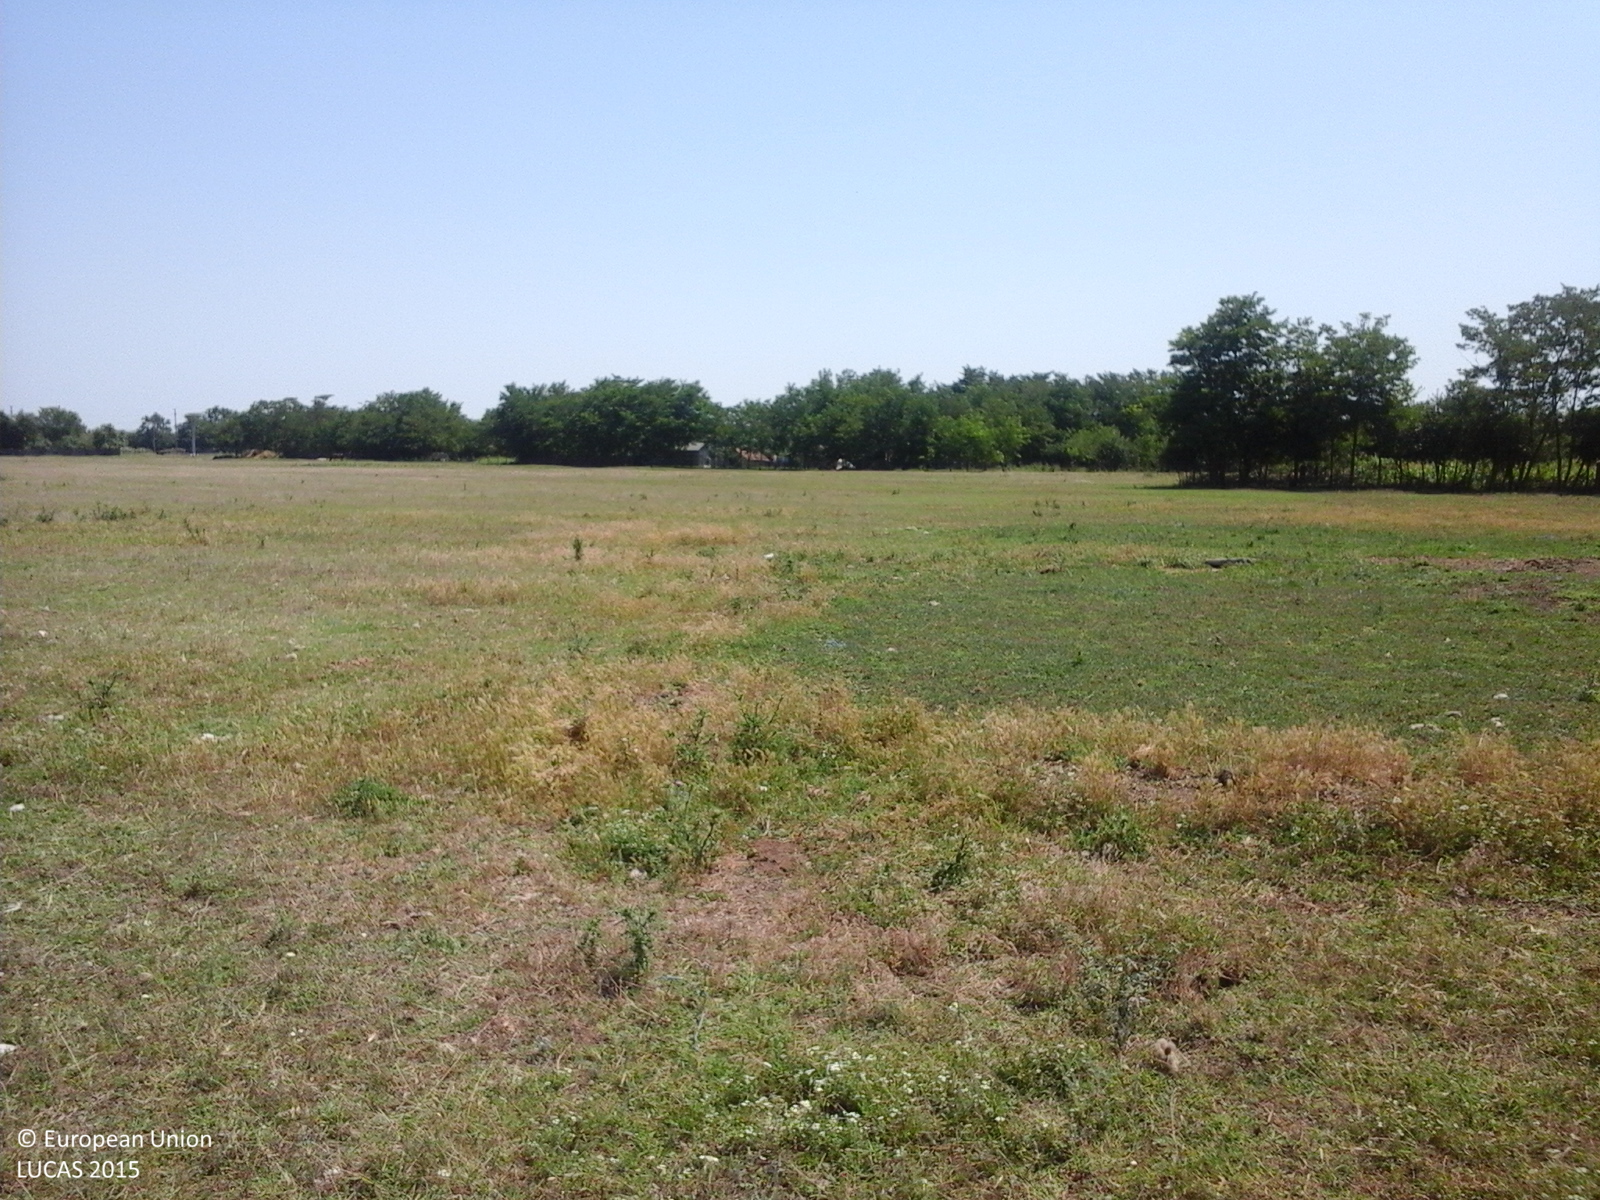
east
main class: Grassland
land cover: Grassland without tree/shrub cover
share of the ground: > 75 %
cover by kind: herbaceous plants 100 %
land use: Agriculture (excluding fallow land and kitchen gardens)
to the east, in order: Grassland without tree/shrub cover; Tracks; Grassland without tree/shrub cover; Lines of trees; Artificial constructions in urban areas; Maize; Abandoned hedges; Fences; Electric lines
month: July
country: RO
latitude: 44.7292
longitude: 26.8317
